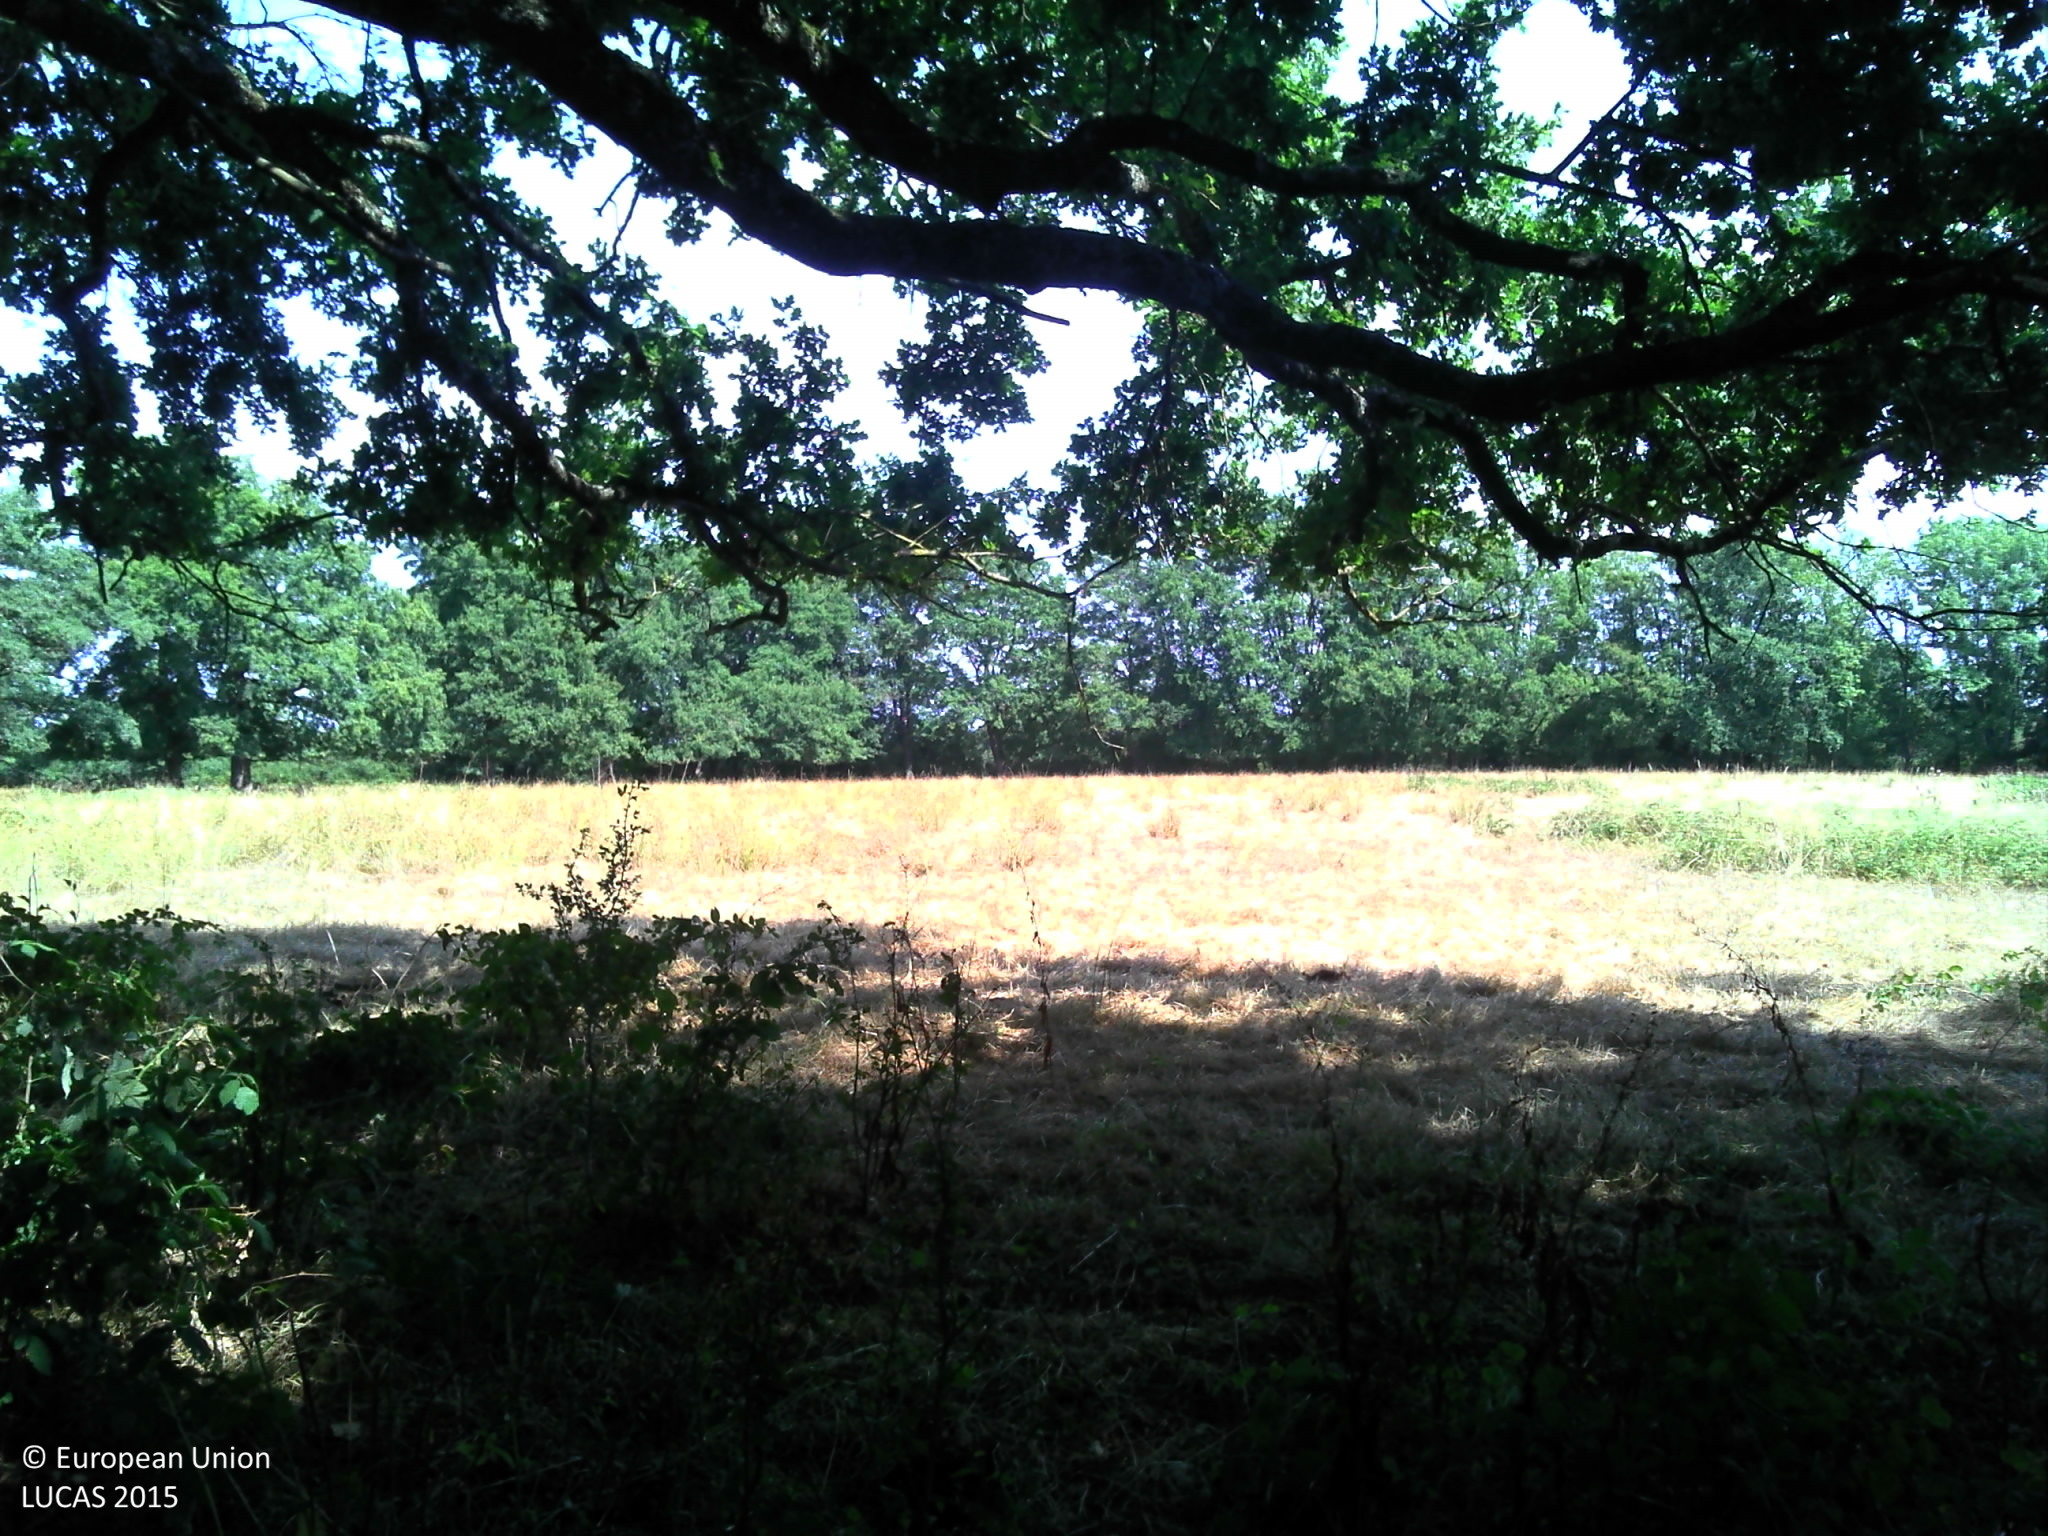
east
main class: Grassland
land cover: Grassland without tree/shrub cover
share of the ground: > 75 %
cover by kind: herbaceous plants 100 %
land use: Agriculture (excluding fallow land and kitchen gardens)
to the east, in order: Grassland without tree/shrub cover; Fences; Broadleaved woodland; Grassland without tree/shrub cover
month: August
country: FR
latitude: 46.7684
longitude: 2.9380
